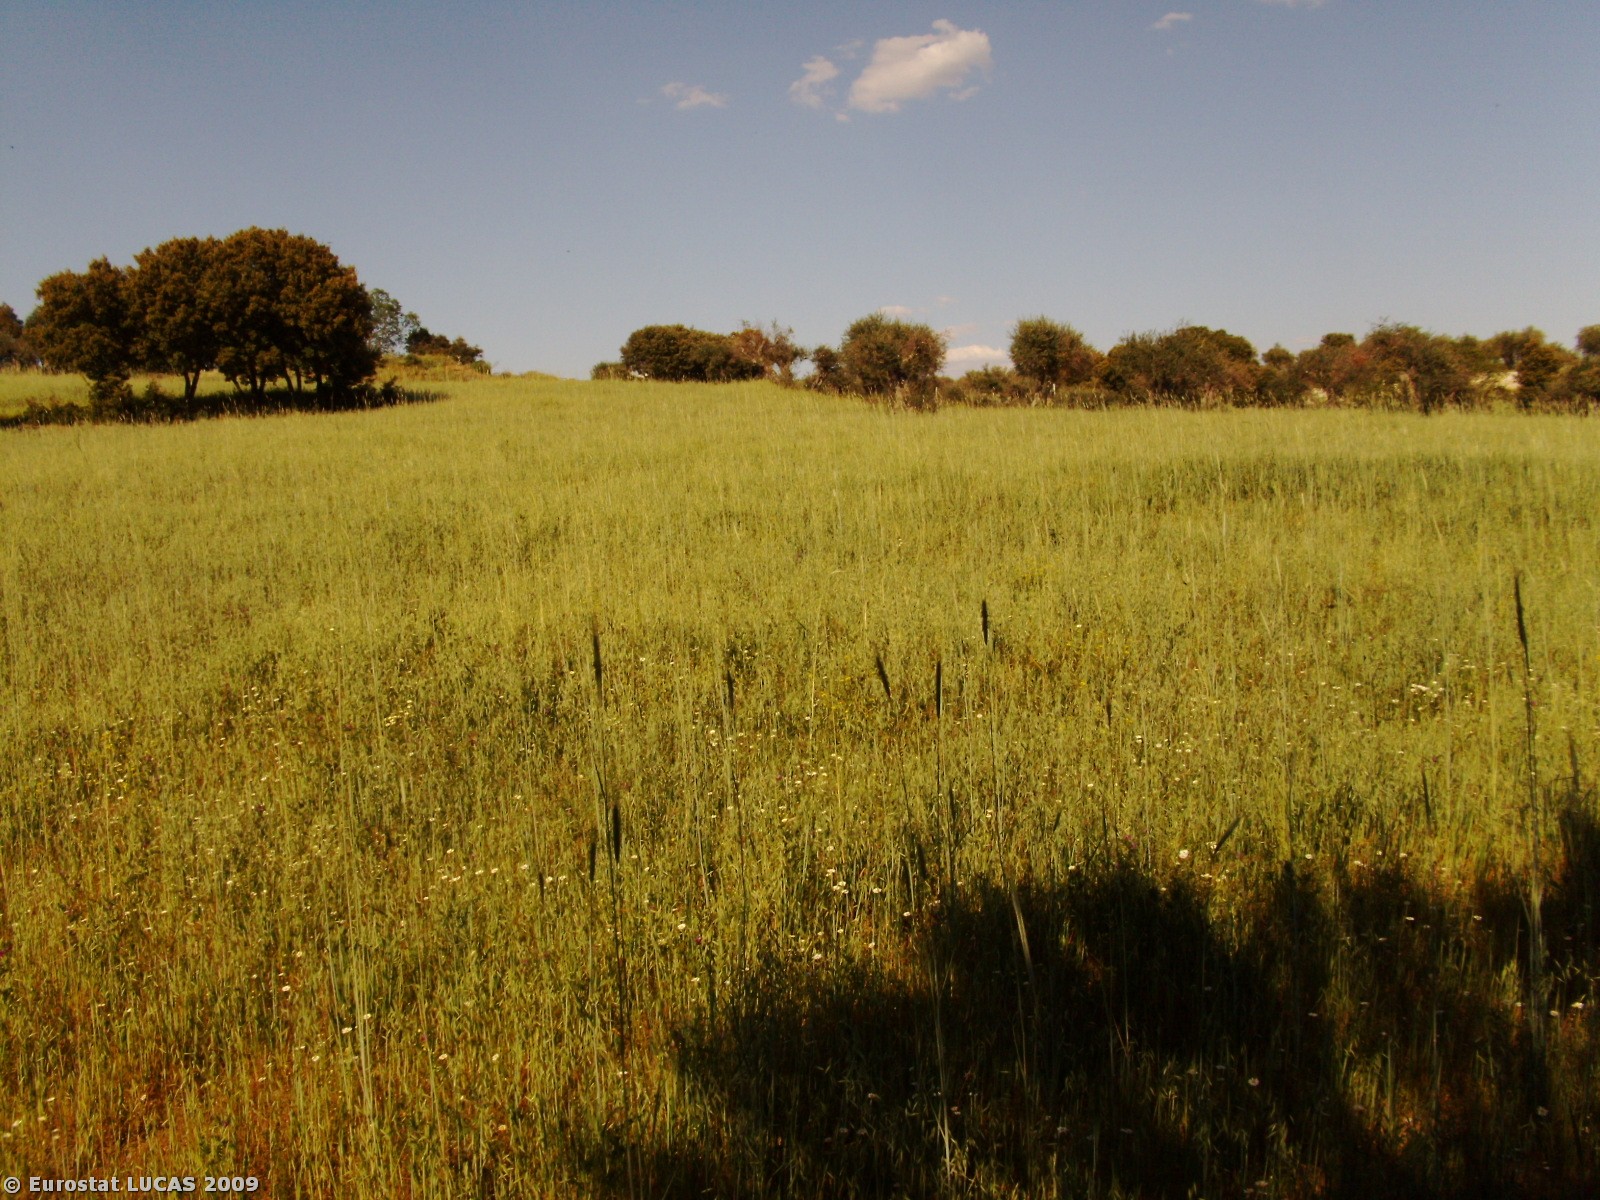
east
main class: Cropland
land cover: Oats
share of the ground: > 75 %
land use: Agriculture (excluding fallow land and kitchen gardens)
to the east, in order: Oats; Olive groves; Abandoned hedges; Rye; Olive groves; Dry stone walls; Paved roads, cycling and walking lanes; Olive groves; Tracks; Shruby margins; Olive groves
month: May
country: PT
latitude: 40.8460
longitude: -6.8363
